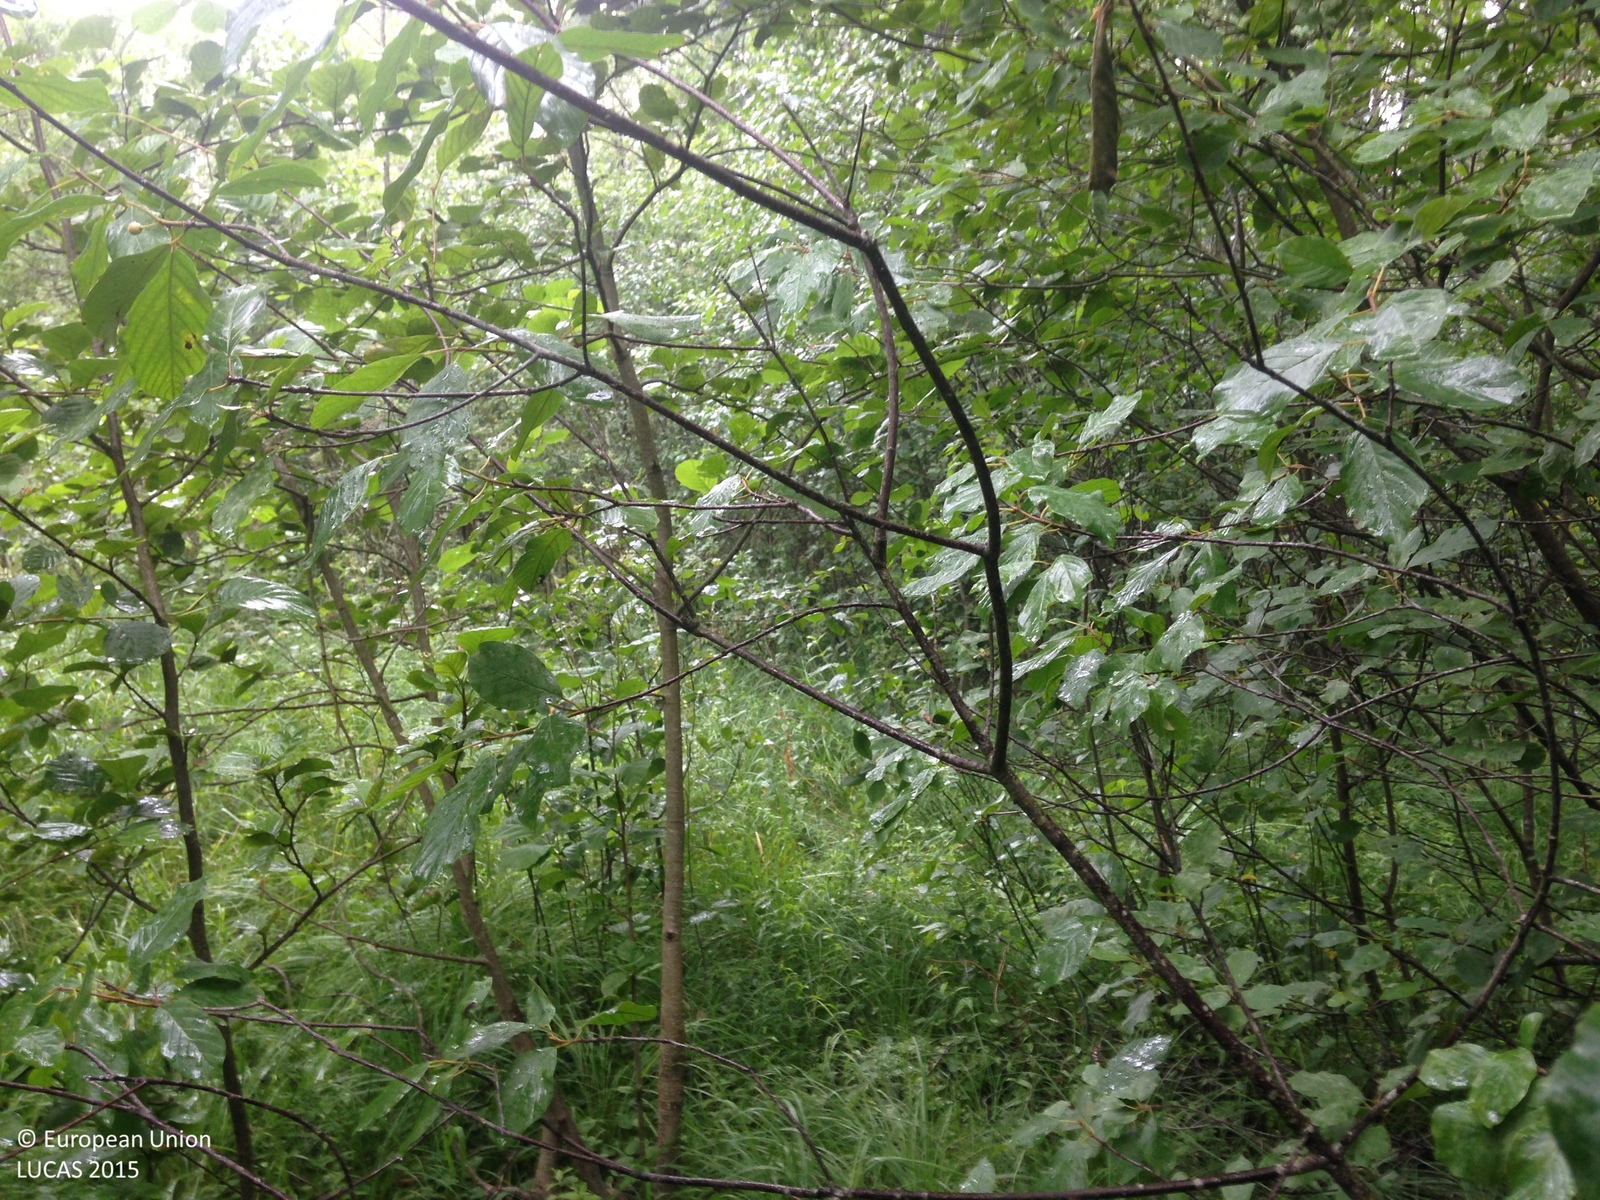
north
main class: Woodland
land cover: Broadleaved woodland
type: hemiboreal forest and nemoral coniferous forest and mixed broadleaved-coniferous forest
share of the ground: 25 - 50 %
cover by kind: herbaceous plants 55 %, broadleaved forest trees 45 %
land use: Forestry
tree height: > 5 m
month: July
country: SE
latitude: 59.1110
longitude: 14.6897
